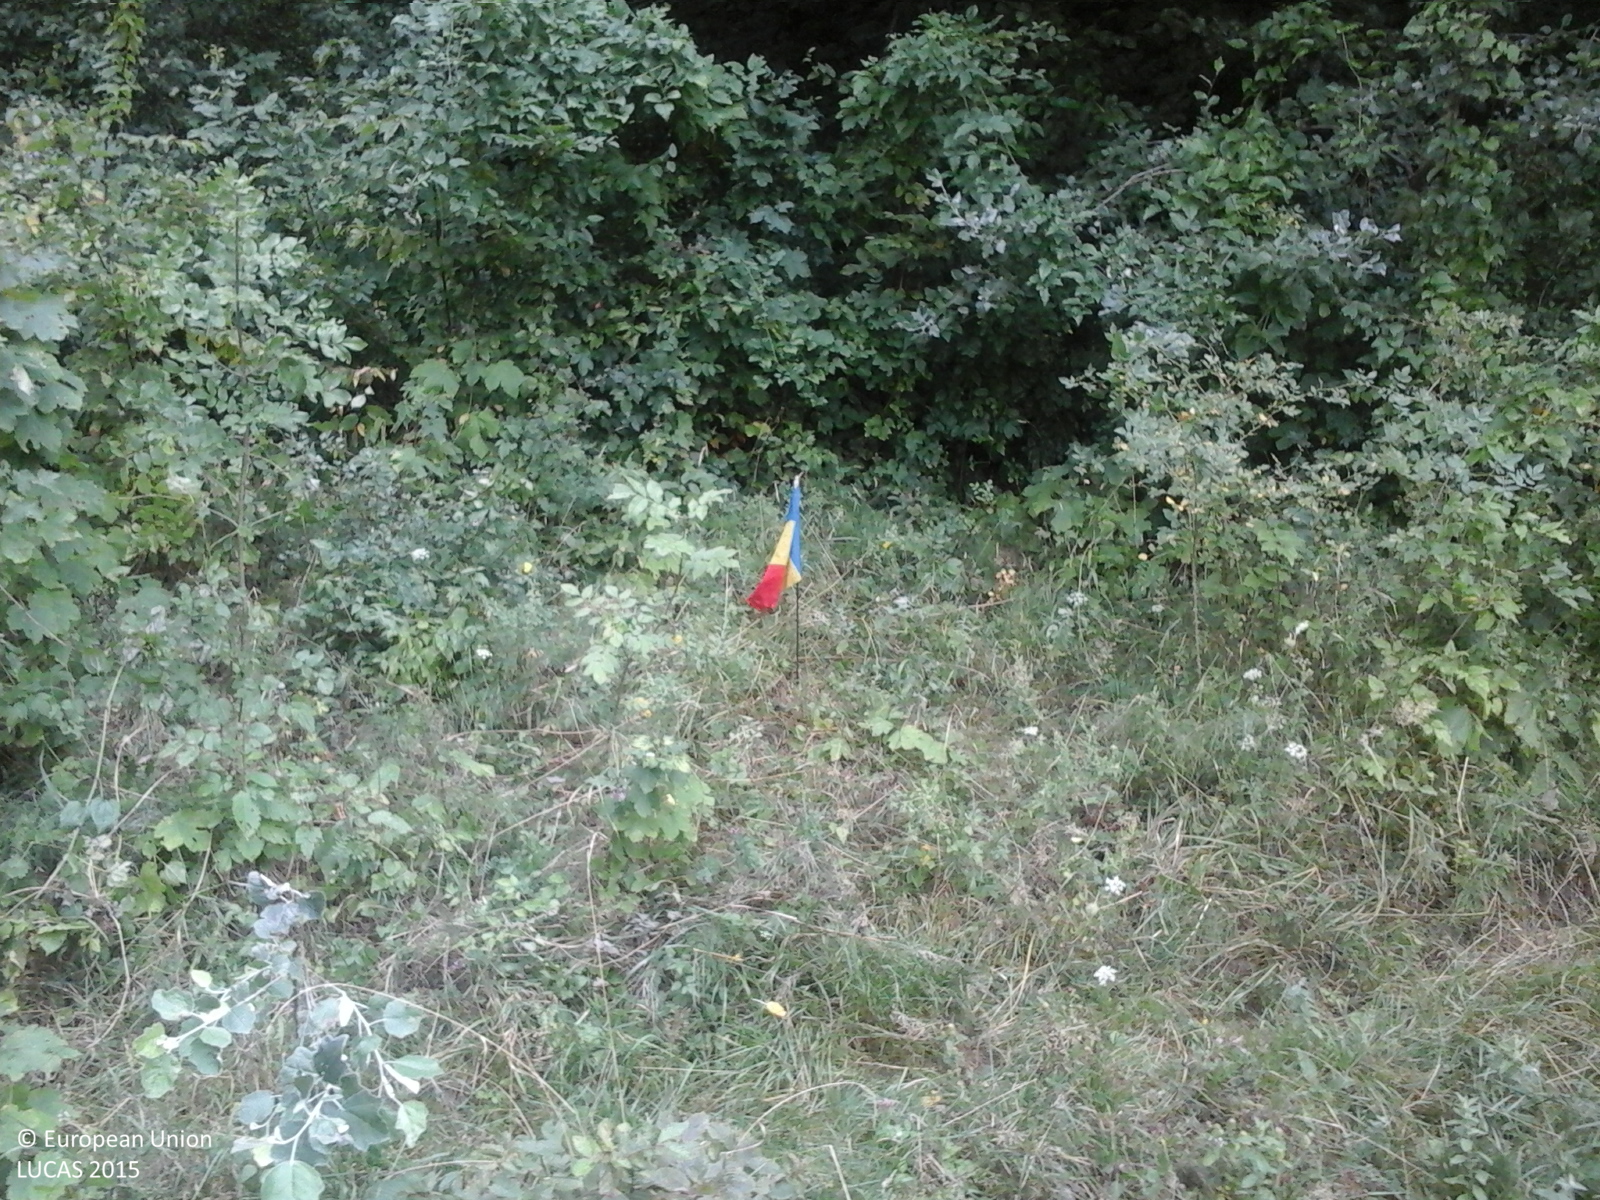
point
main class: Woodland
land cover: Broadleaved woodland
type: beech forest
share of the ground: > 75 %
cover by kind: broadleaved forest trees 80 %, herbaceous plants 20 %
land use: Forestry
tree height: > 5 m
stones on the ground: < 10 %
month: August
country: RO
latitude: 44.6509
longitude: 23.0734
